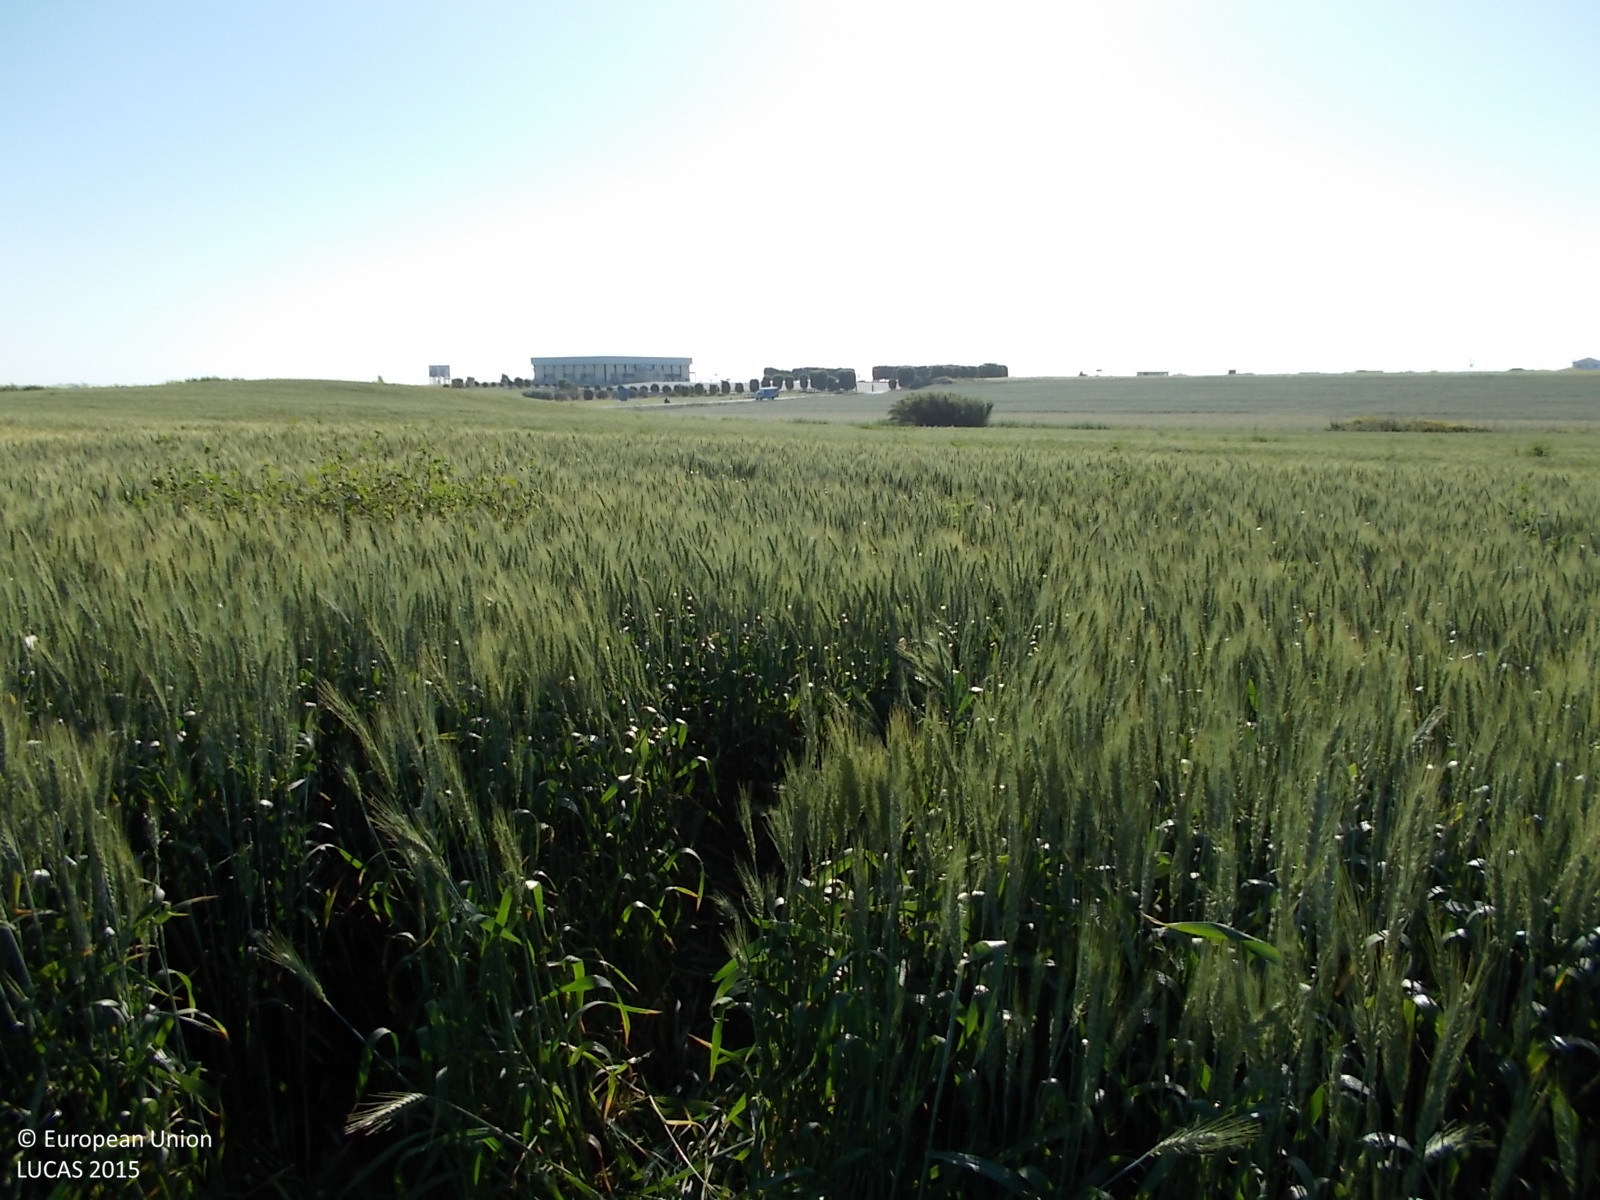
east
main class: Cropland
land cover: Common wheat
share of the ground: > 75 %
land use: Agriculture (excluding fallow land and kitchen gardens)
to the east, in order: Common wheat; Abandoned hedges; Common wheat
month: April
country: CY
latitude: 34.8887
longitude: 33.5762
